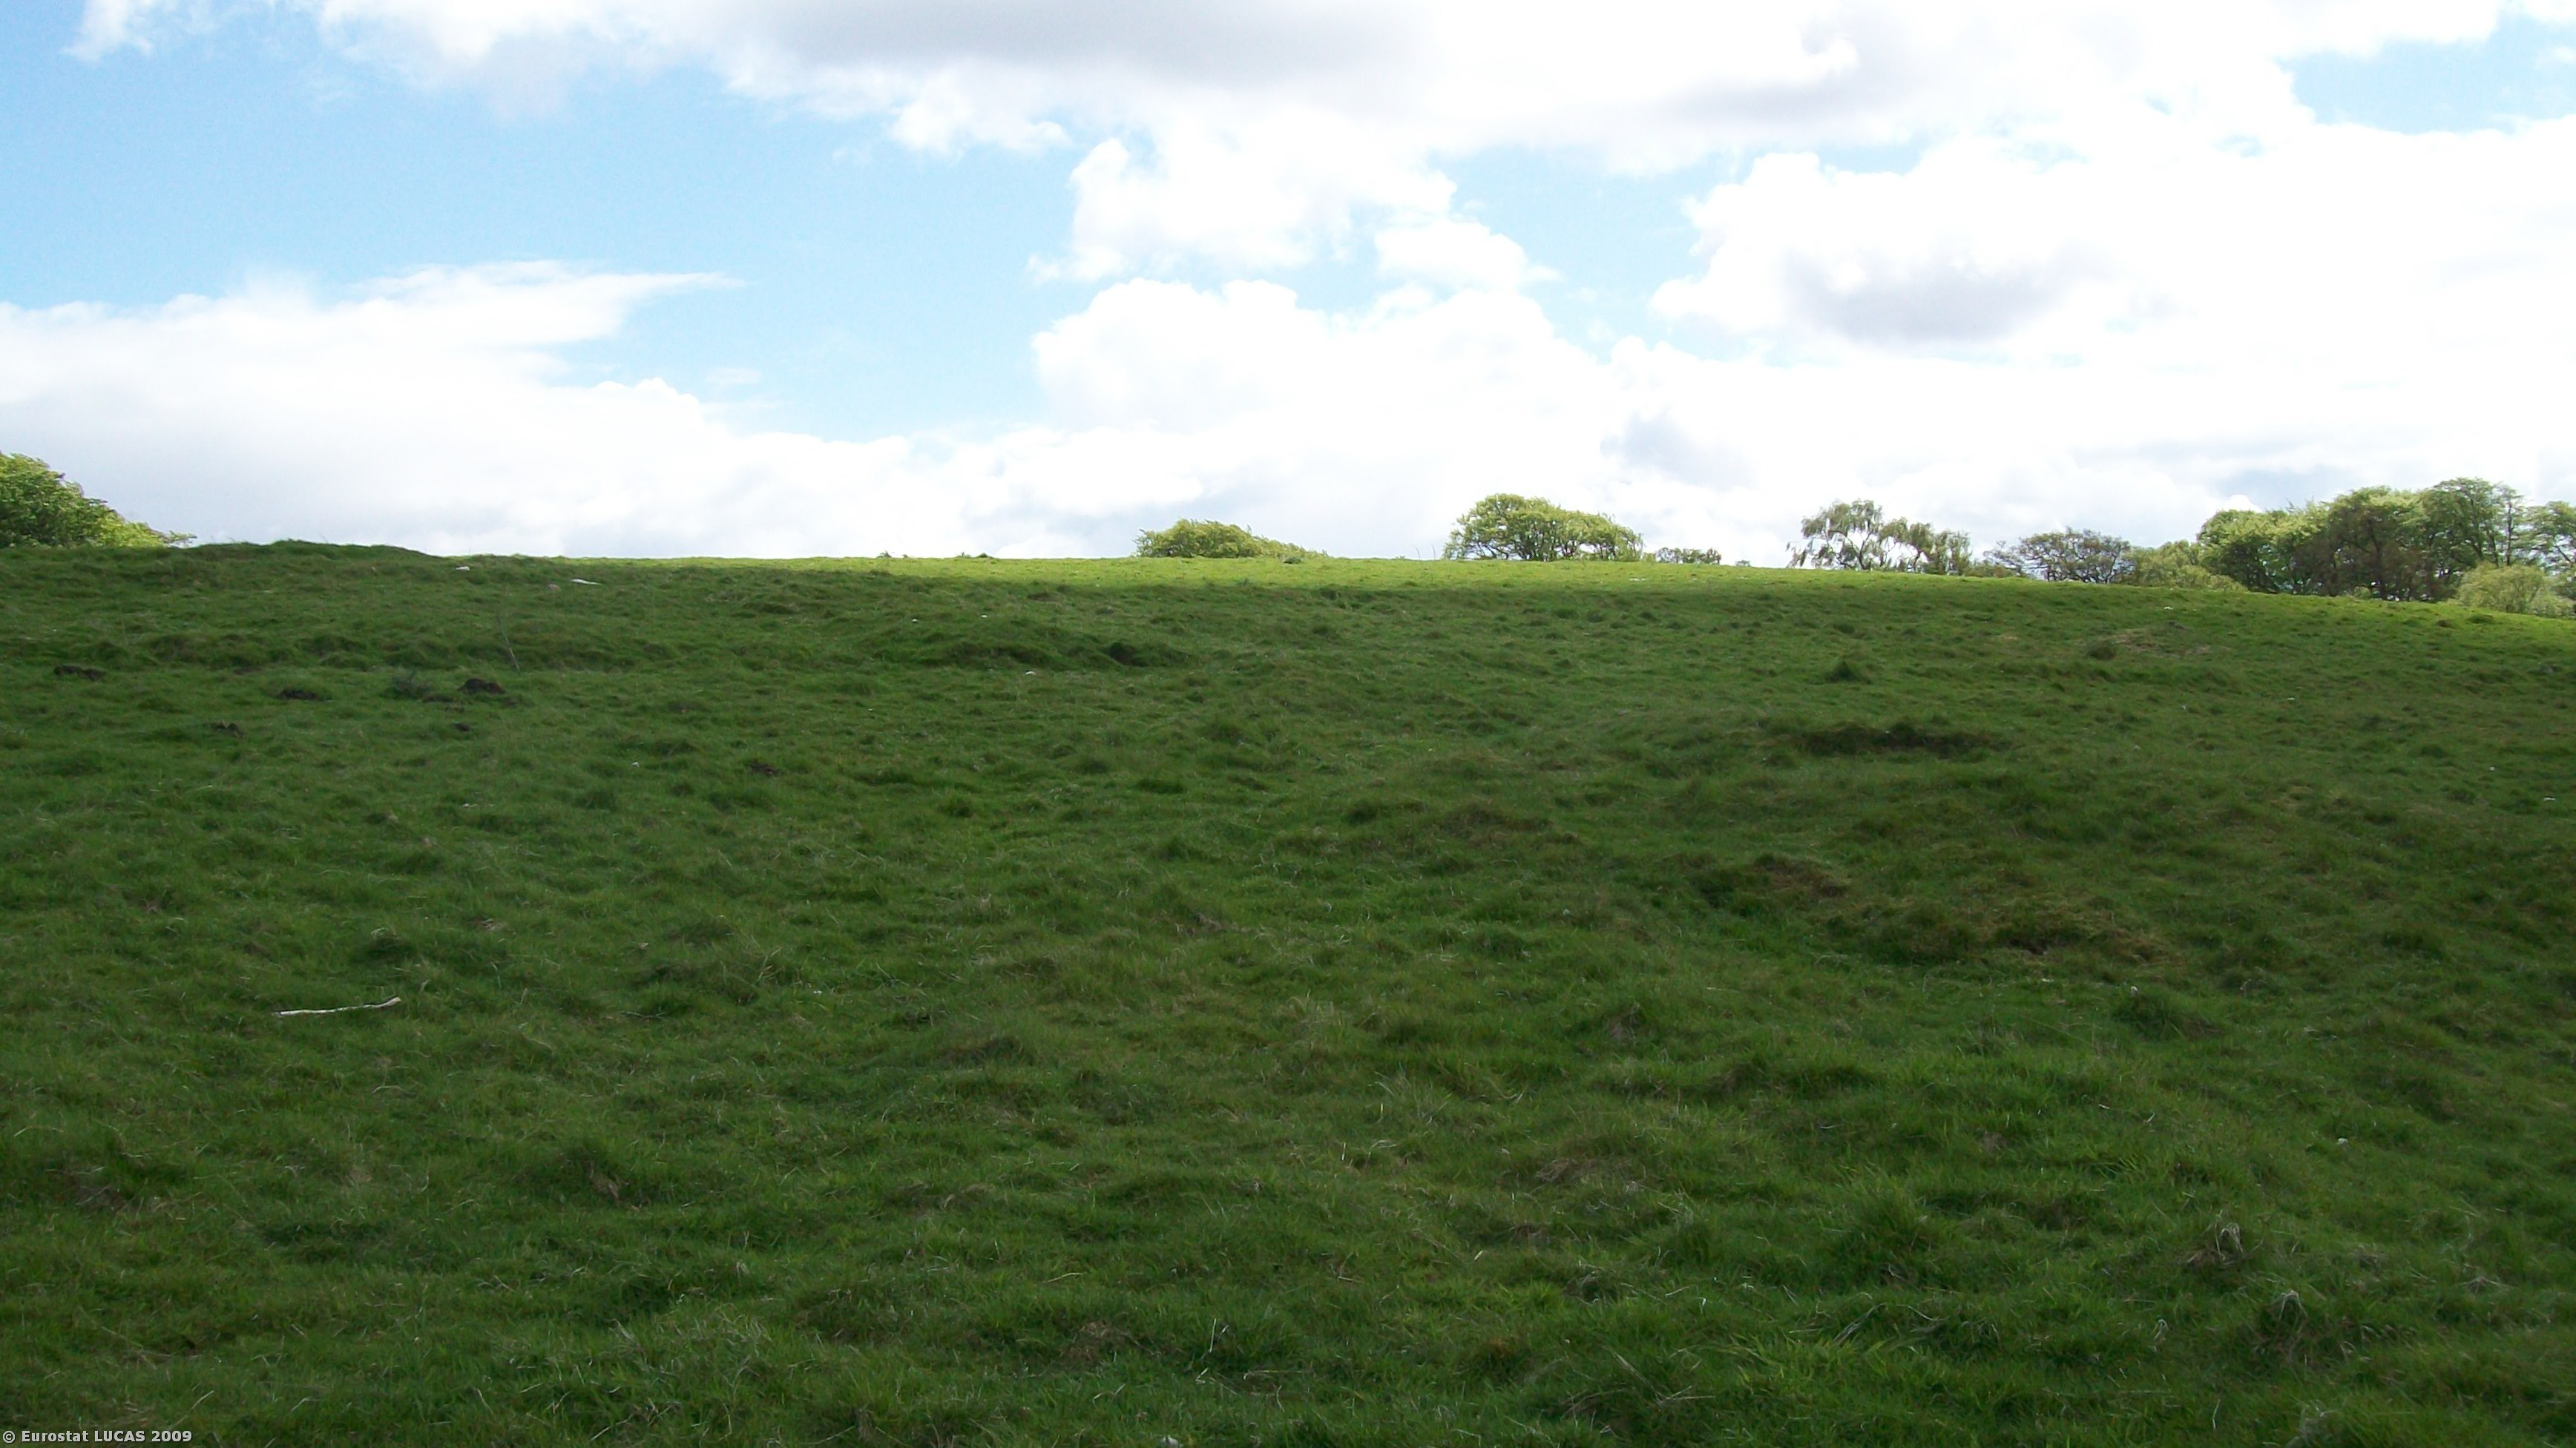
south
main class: Grassland
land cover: Grassland without tree/shrub cover
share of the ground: > 75 %
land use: Agriculture (excluding fallow land and kitchen gardens)
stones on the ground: 10 - 25 %
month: May
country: GB
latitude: 55.8880
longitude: -3.6875
